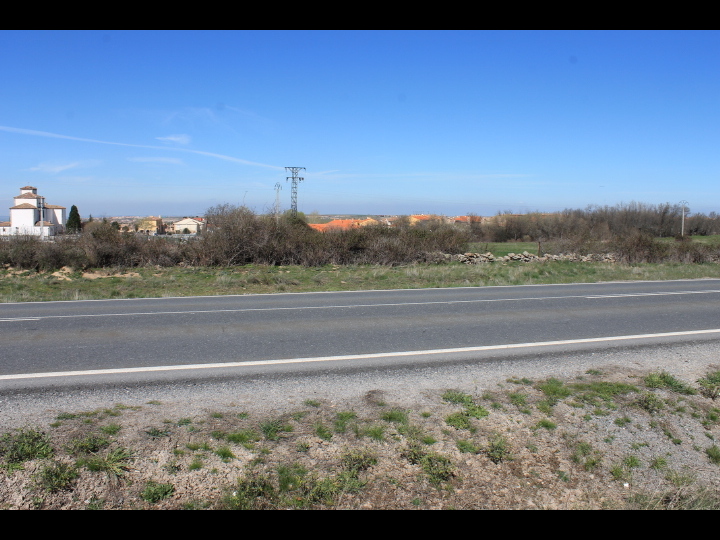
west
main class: Grassland
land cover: Grassland without tree/shrub cover
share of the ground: > 75 %
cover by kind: herbaceous plants 95 %, unconsolidated bare surface 5 %
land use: Agriculture (excluding fallow land and kitchen gardens)
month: April
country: ES
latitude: 40.9575
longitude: -4.0329
